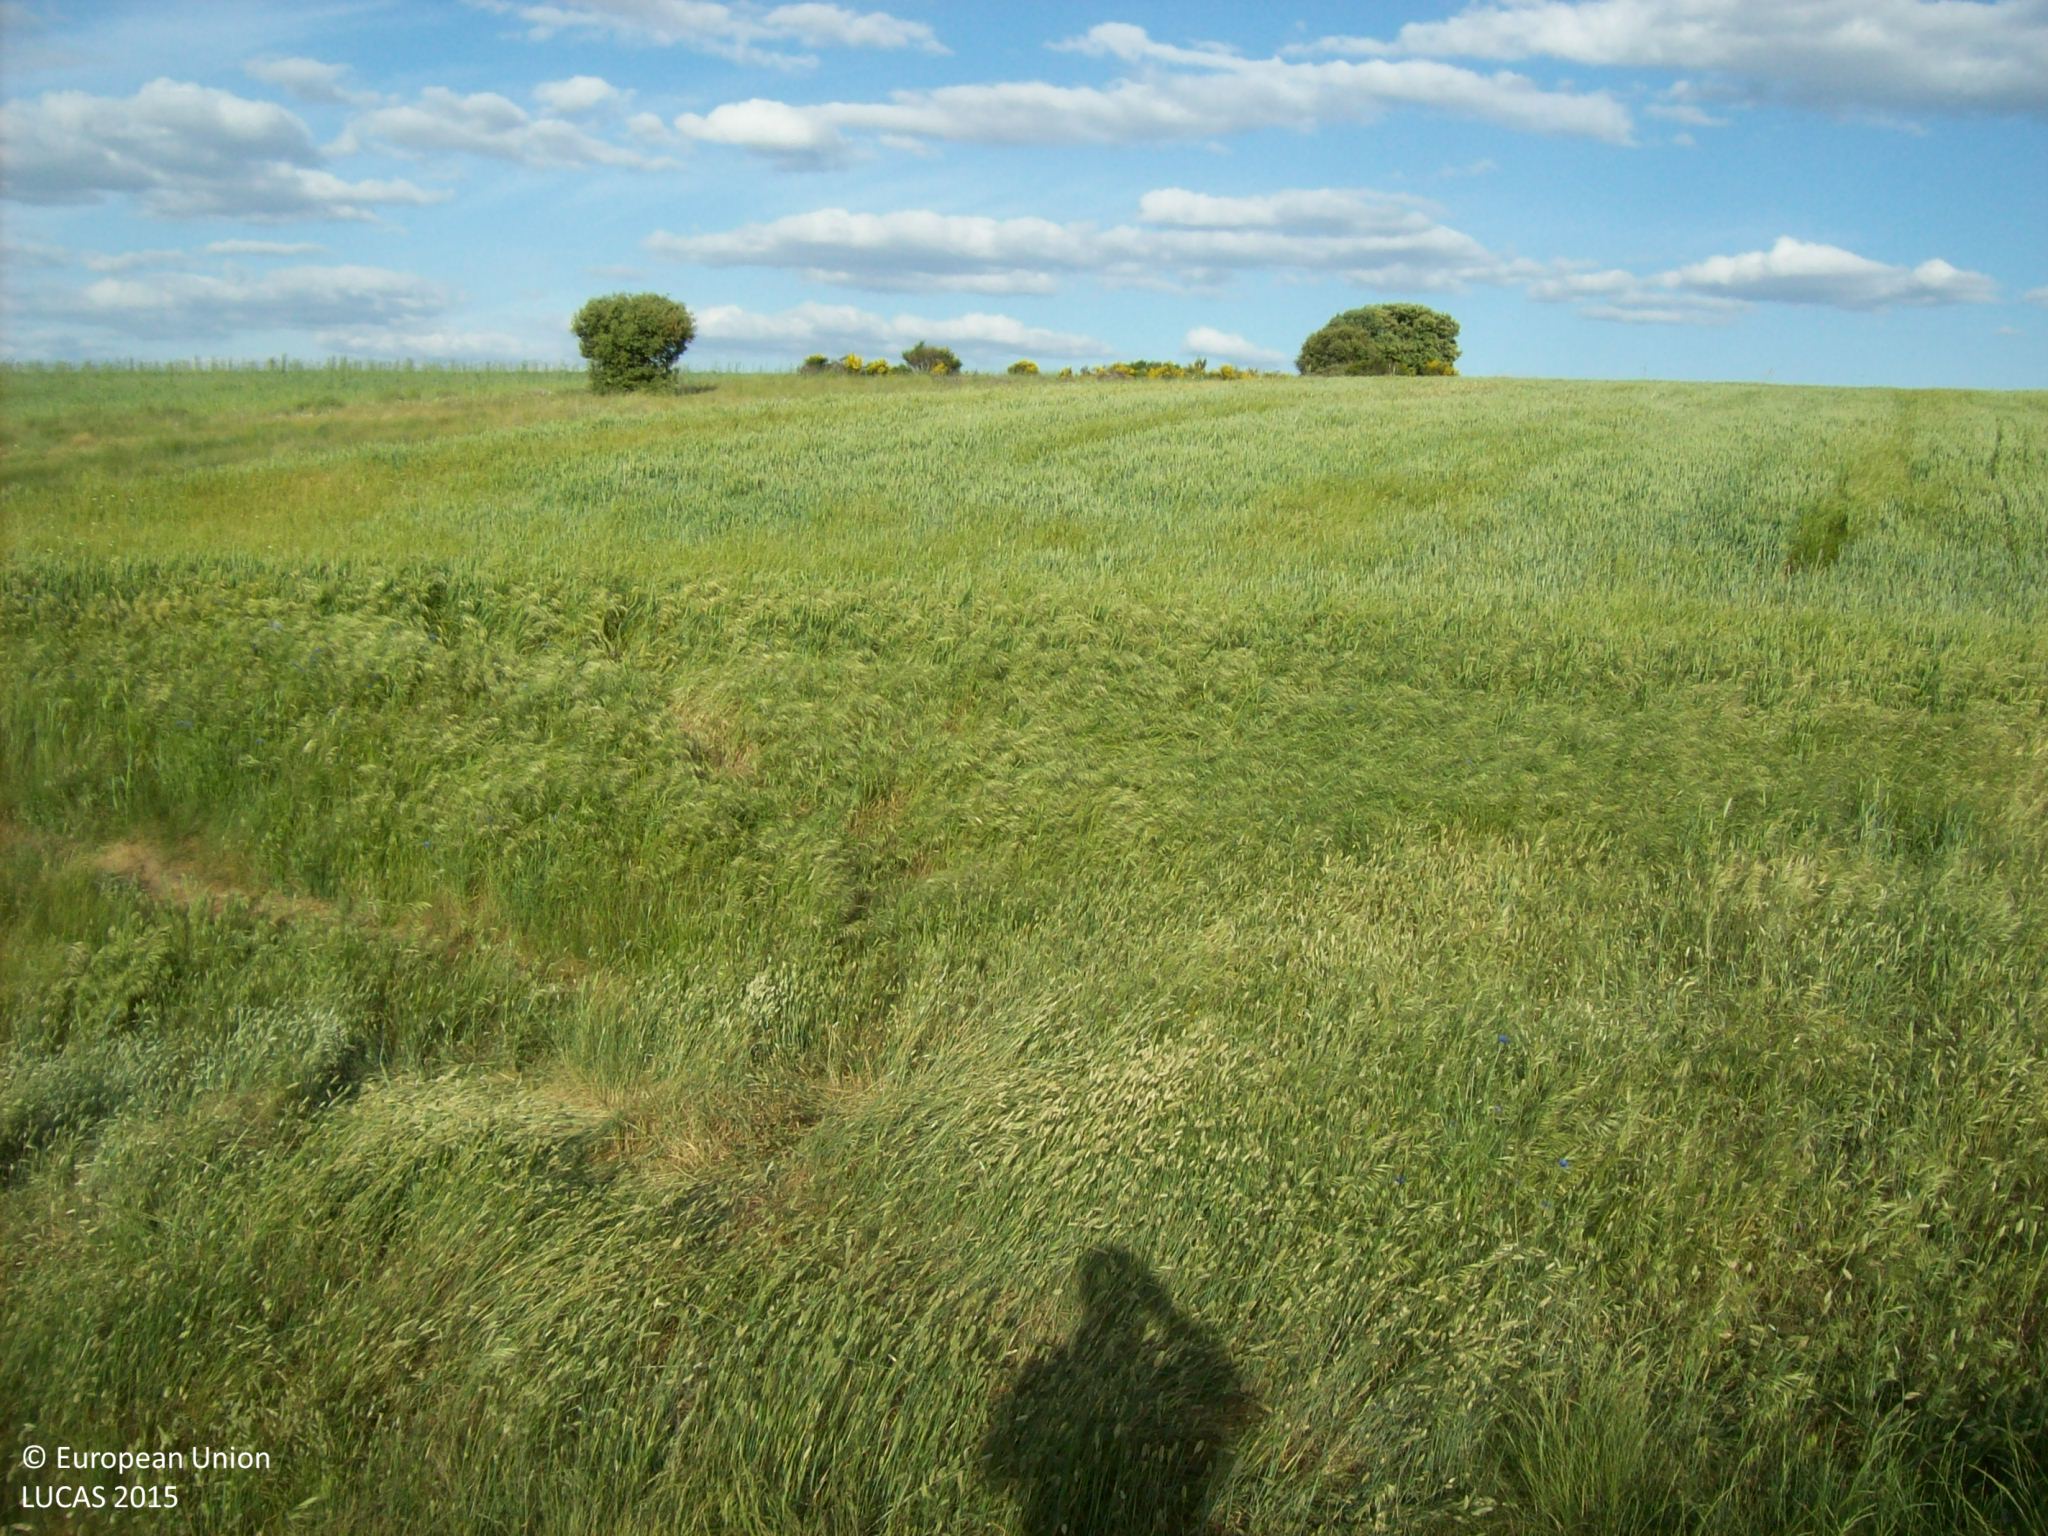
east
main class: Grassland
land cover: Grassland without tree/shrub cover
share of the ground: > 75 %
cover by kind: herbaceous plants 80 %, unconsolidated bare surface 15 %
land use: Semi-natural and natural areas not in use
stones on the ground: < 10 %
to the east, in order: Grassland without tree/shrub cover; Common wheat; Shrubland with sparse tree cover; Common wheat; Grass margins; Tracks; Grass margins; Other bare soil; Grass margins; Tracks; Grass margins; Mixed cereals for fodder; Grass margins; Mixed cereals for fodder
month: May
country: ES
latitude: 40.8188
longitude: -4.4831
